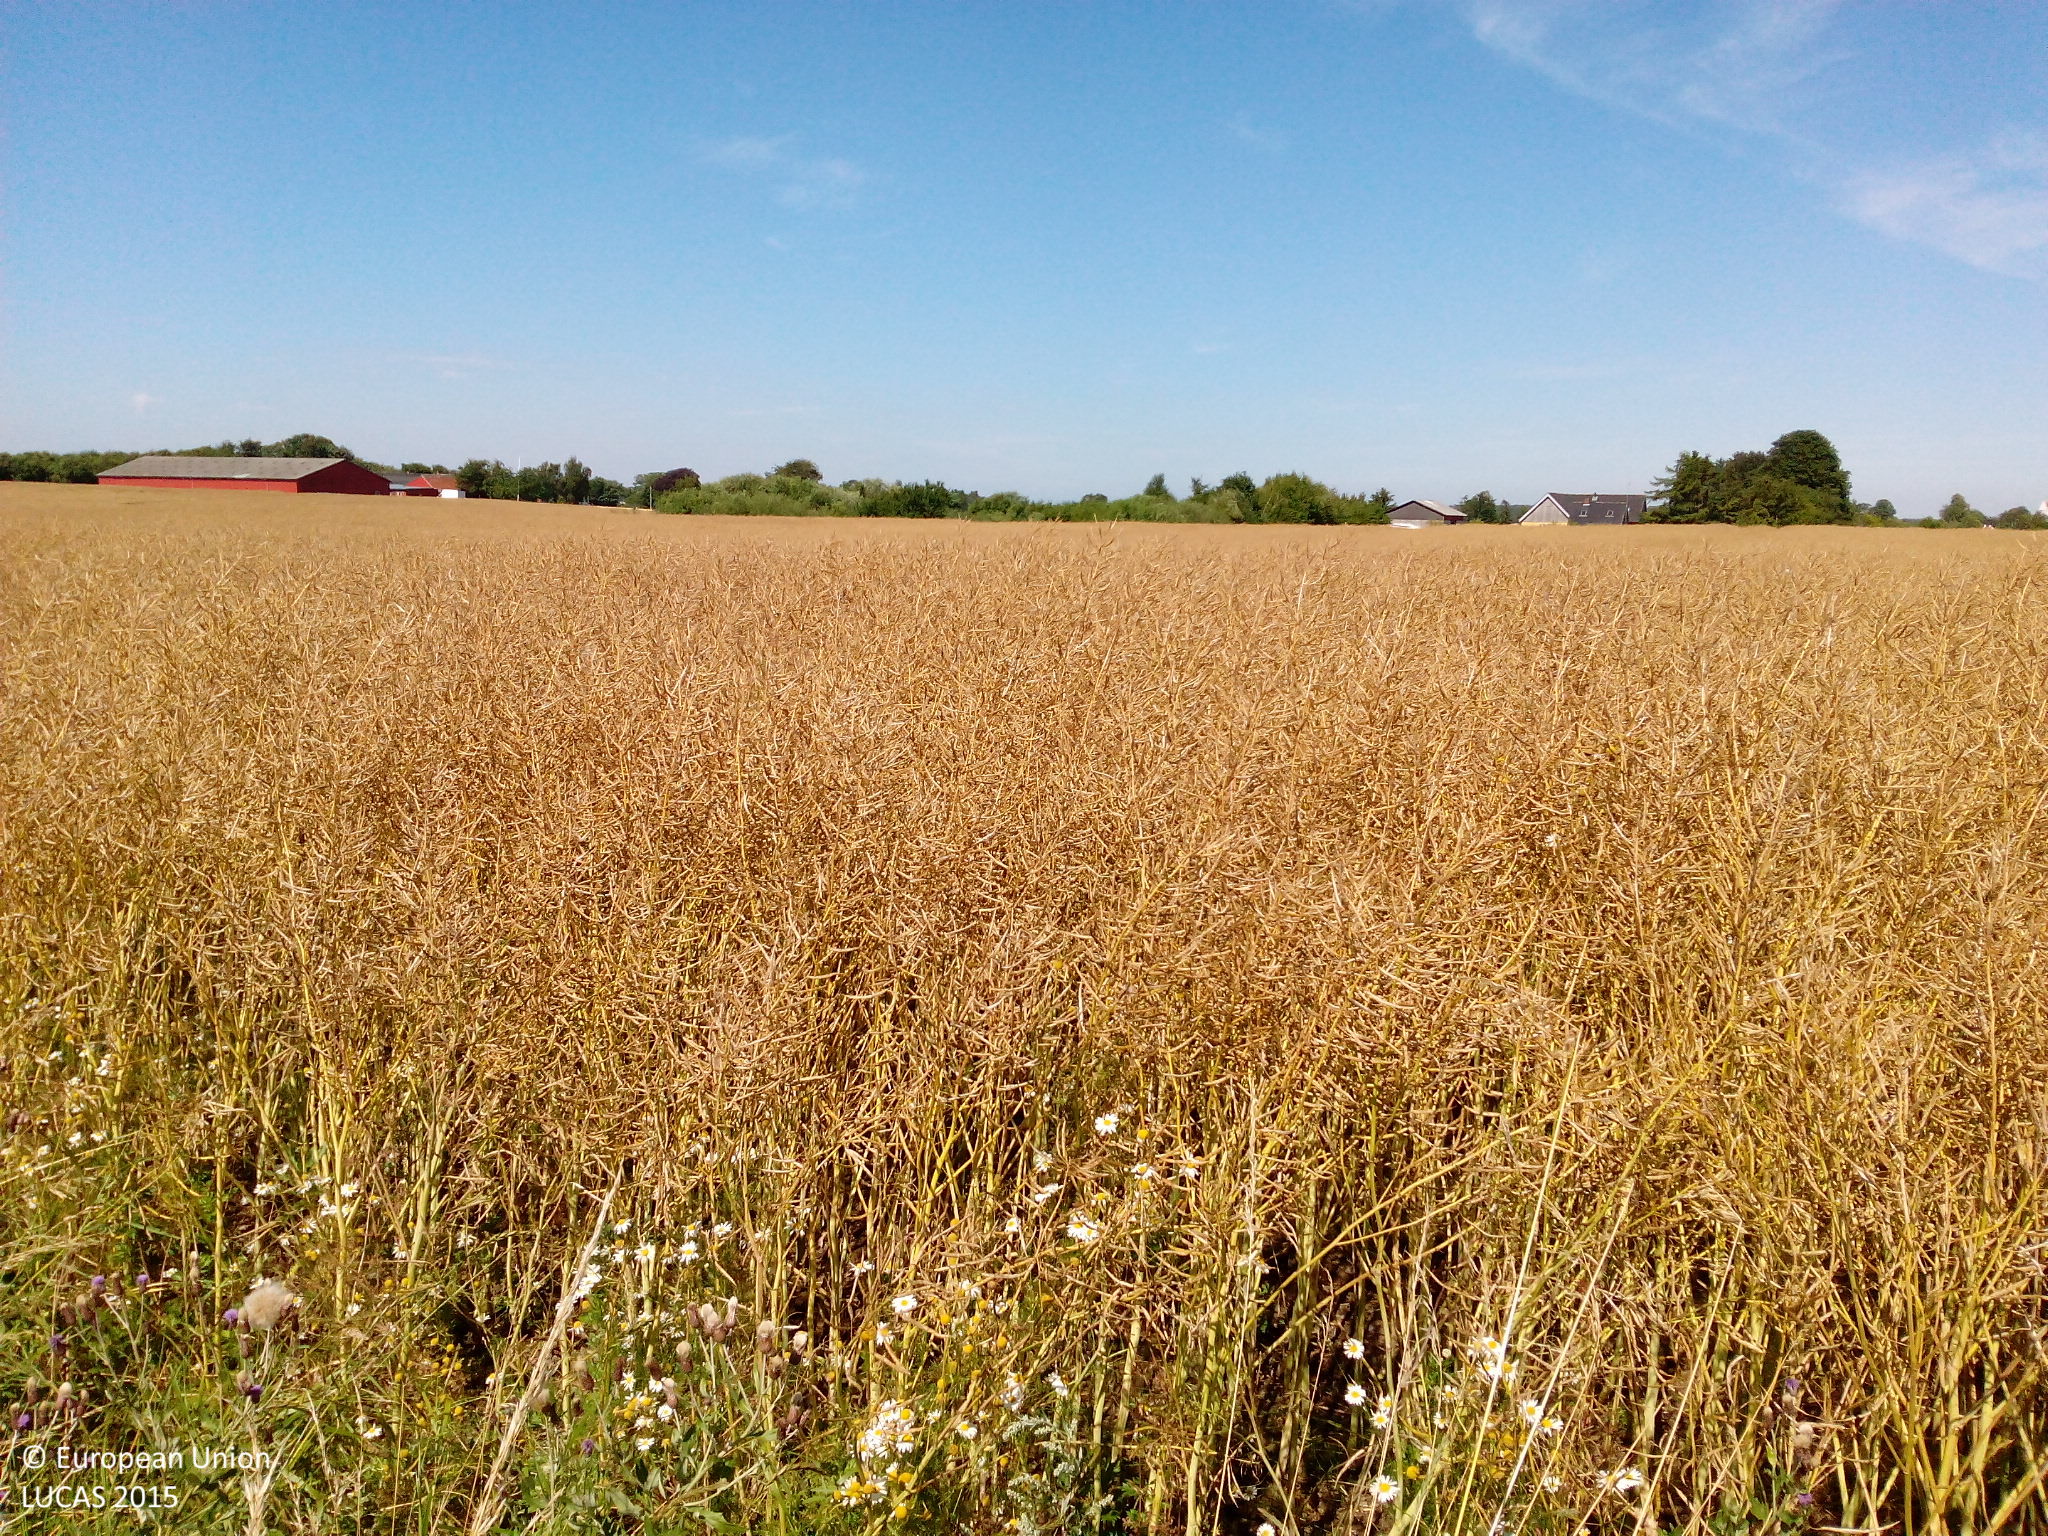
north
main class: Cropland
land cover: Rape and turnip rape
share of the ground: > 75 %
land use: Agriculture (excluding fallow land and kitchen gardens)
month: August
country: DK
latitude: 55.5999
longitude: 11.7918
